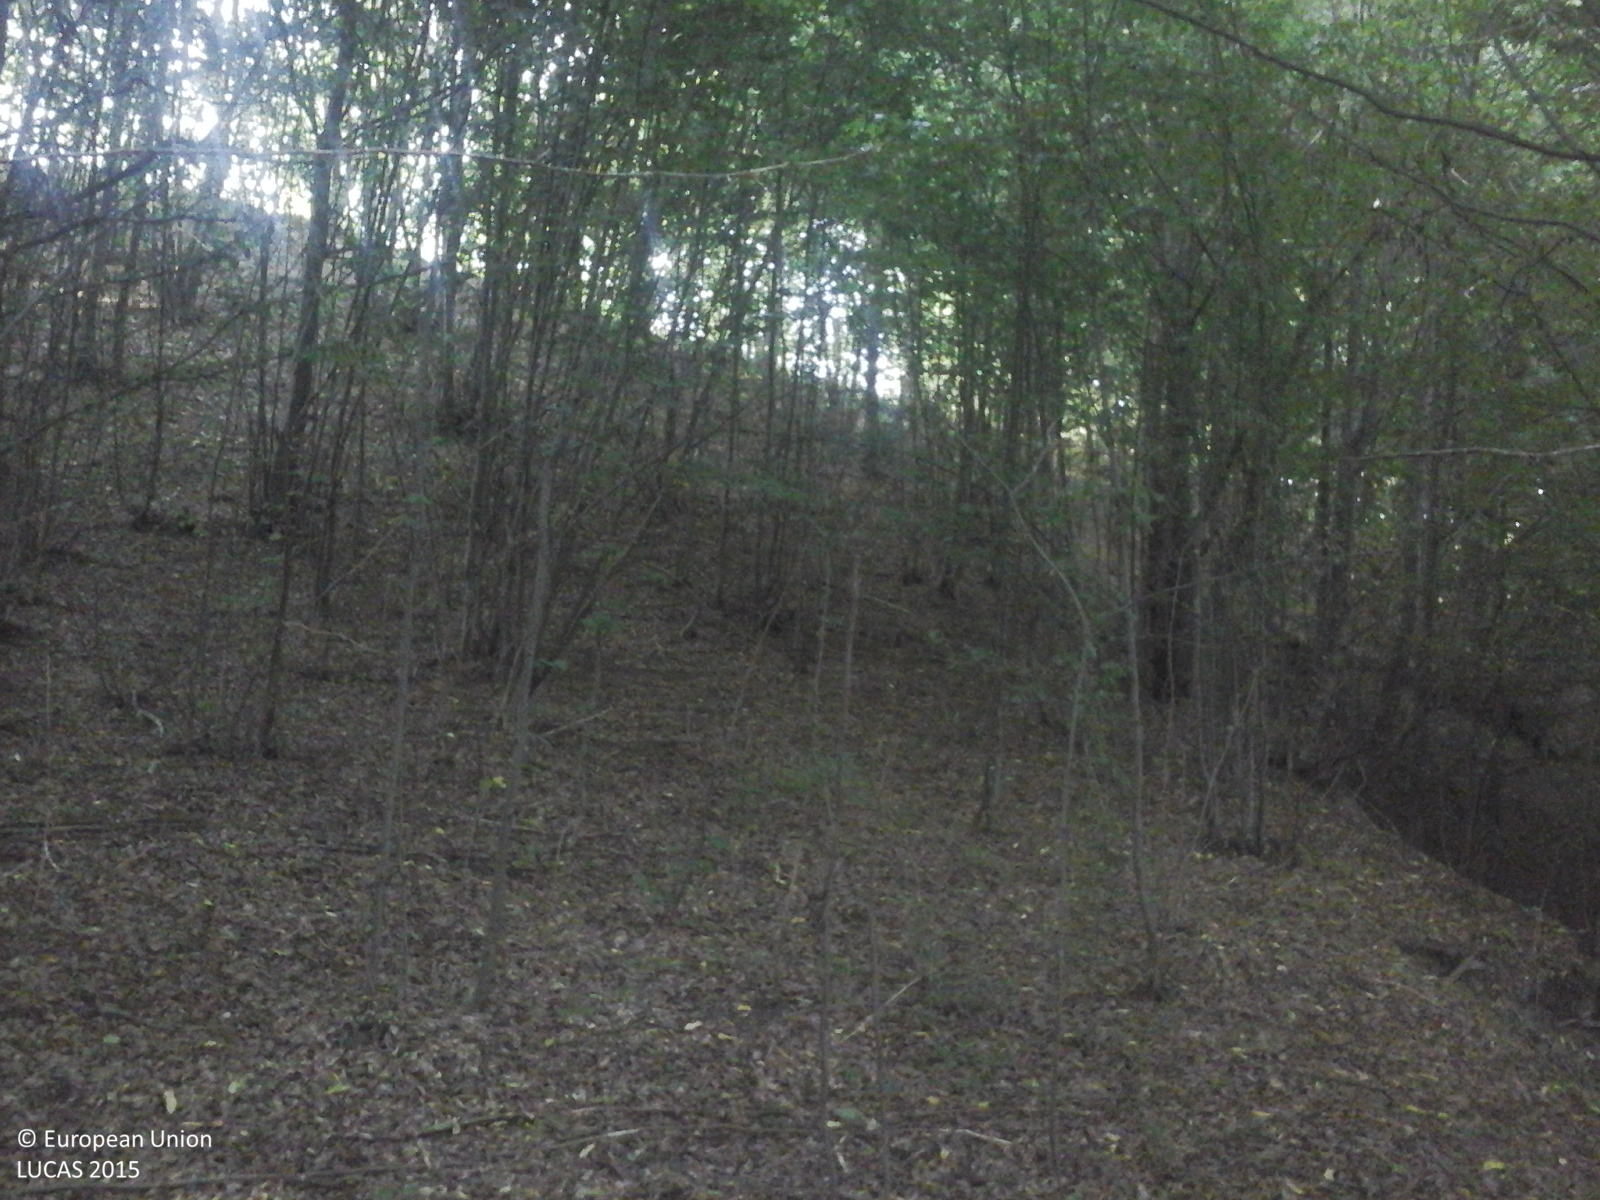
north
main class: Woodland
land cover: Broadleaved woodland
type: beech forest
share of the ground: > 75 %
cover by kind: broadleaved forest trees 100 %
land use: Forestry
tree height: > 5 m
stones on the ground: 10 - 25 %
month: July
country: RO
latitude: 45.0584
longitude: 24.5406
